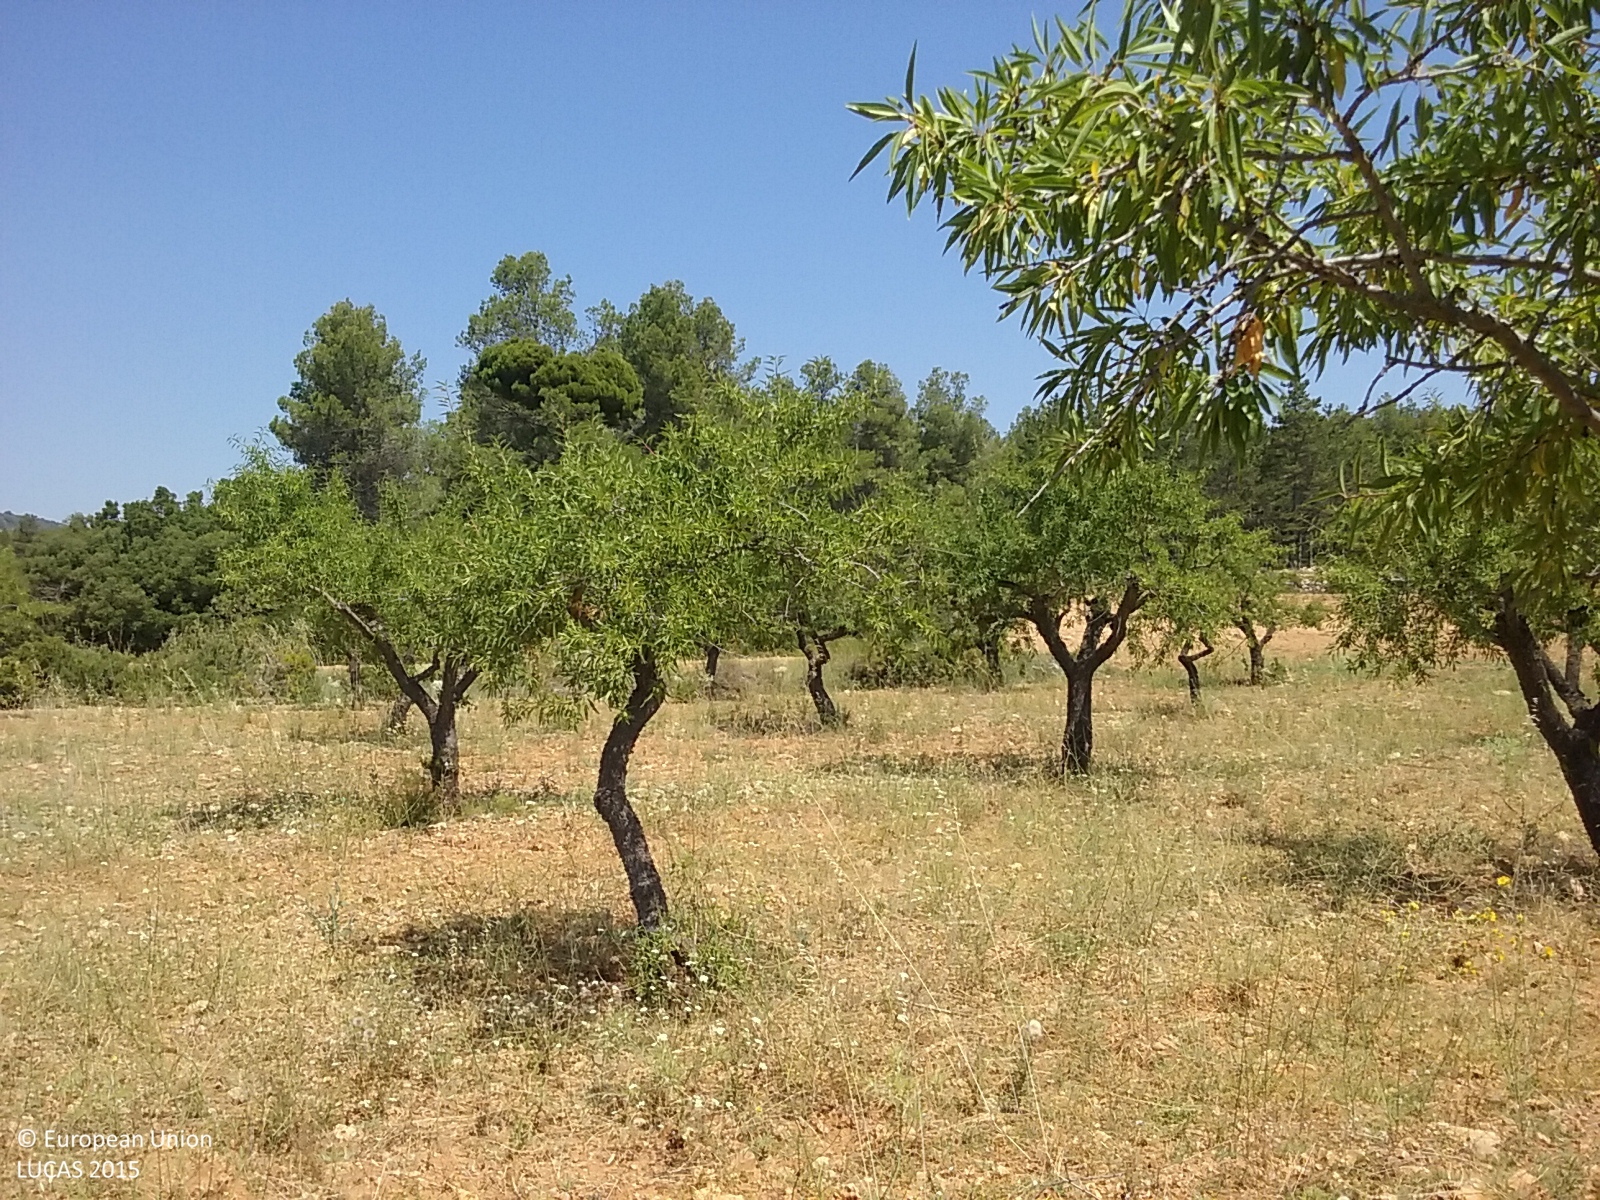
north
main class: Cropland
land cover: Nuts trees
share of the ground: 10 - 25 %
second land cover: Spontaneously vegetated surfaces
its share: 25 - 50 %
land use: Agriculture (excluding fallow land and kitchen gardens)
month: July
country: ES
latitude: 39.9371
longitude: -0.6882
